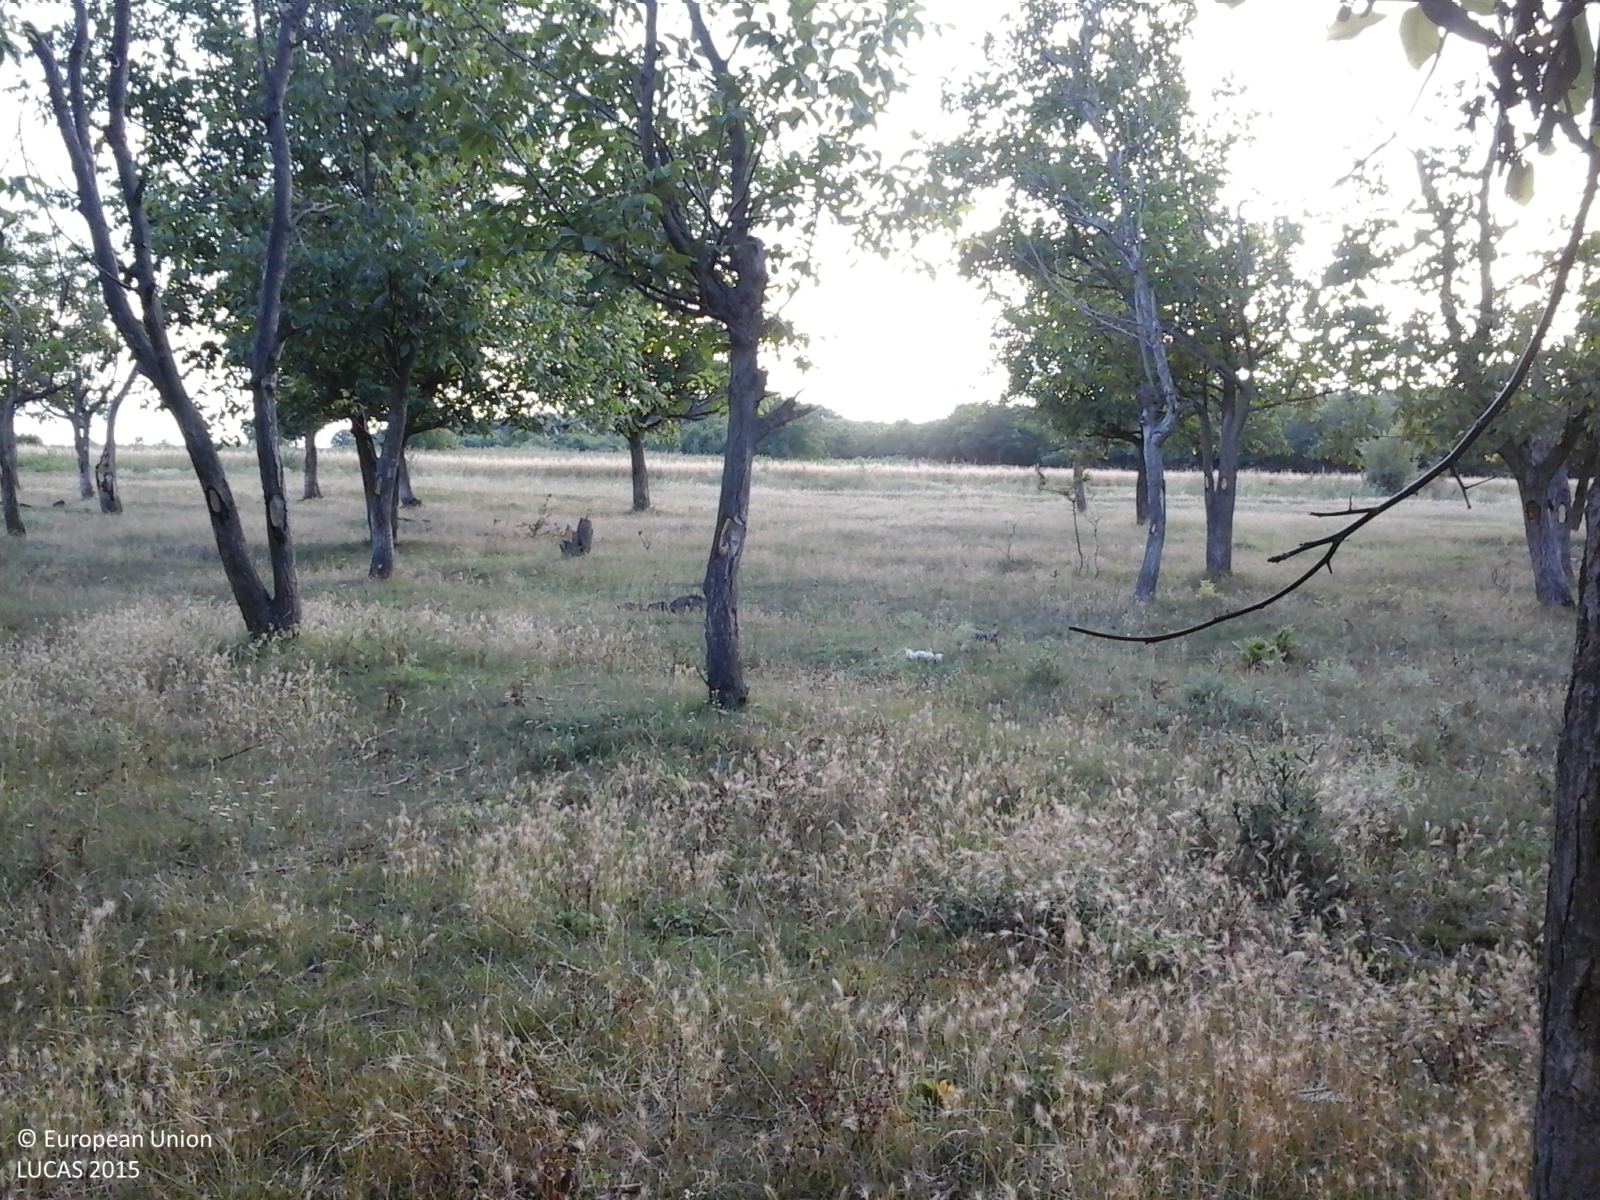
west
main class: Cropland
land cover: Nuts trees
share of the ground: 50 - 75 %
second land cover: Grassland without tree/shrub cover
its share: > 75 %
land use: Agriculture (excluding fallow land and kitchen gardens)
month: July
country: RO
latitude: 43.9432
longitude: 24.4045
